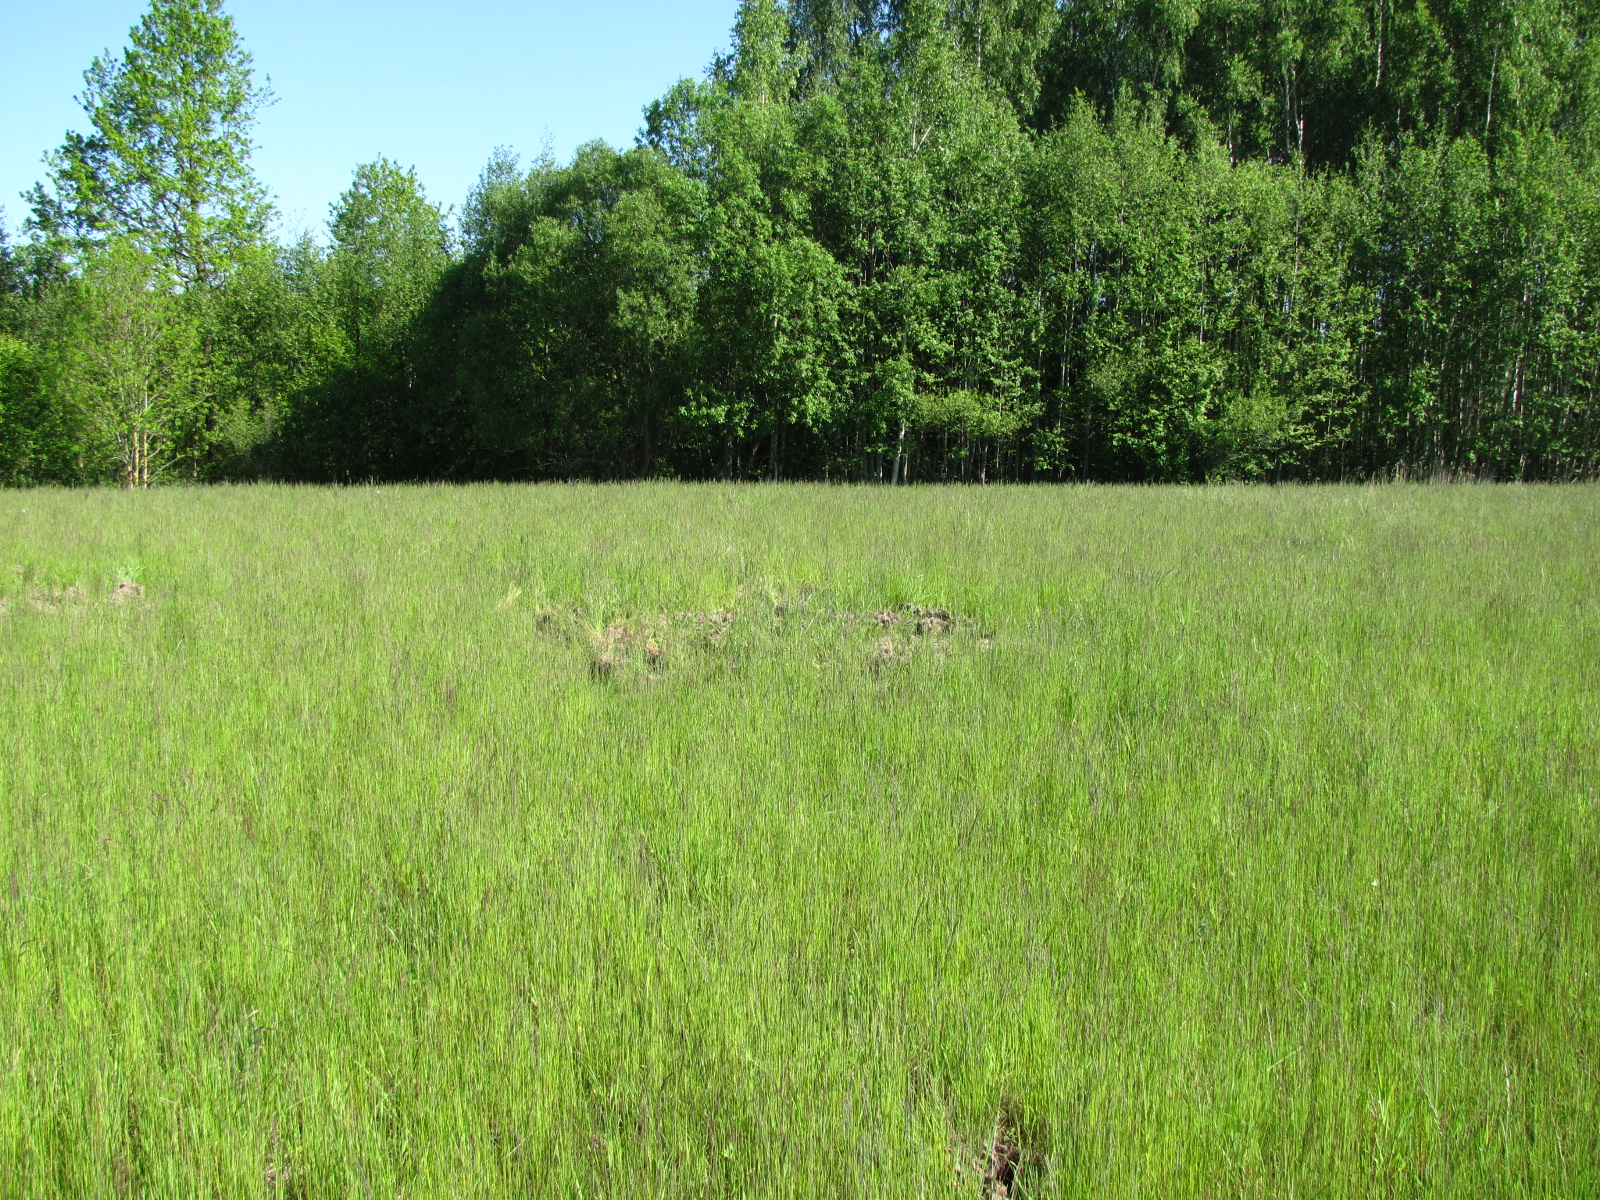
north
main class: Grassland
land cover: Grassland without tree/shrub cover
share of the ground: > 75 %
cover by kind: herbaceous plants 100 %
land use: Agriculture (excluding fallow land and kitchen gardens)
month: May
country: LV
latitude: 56.5600
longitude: 24.0630
